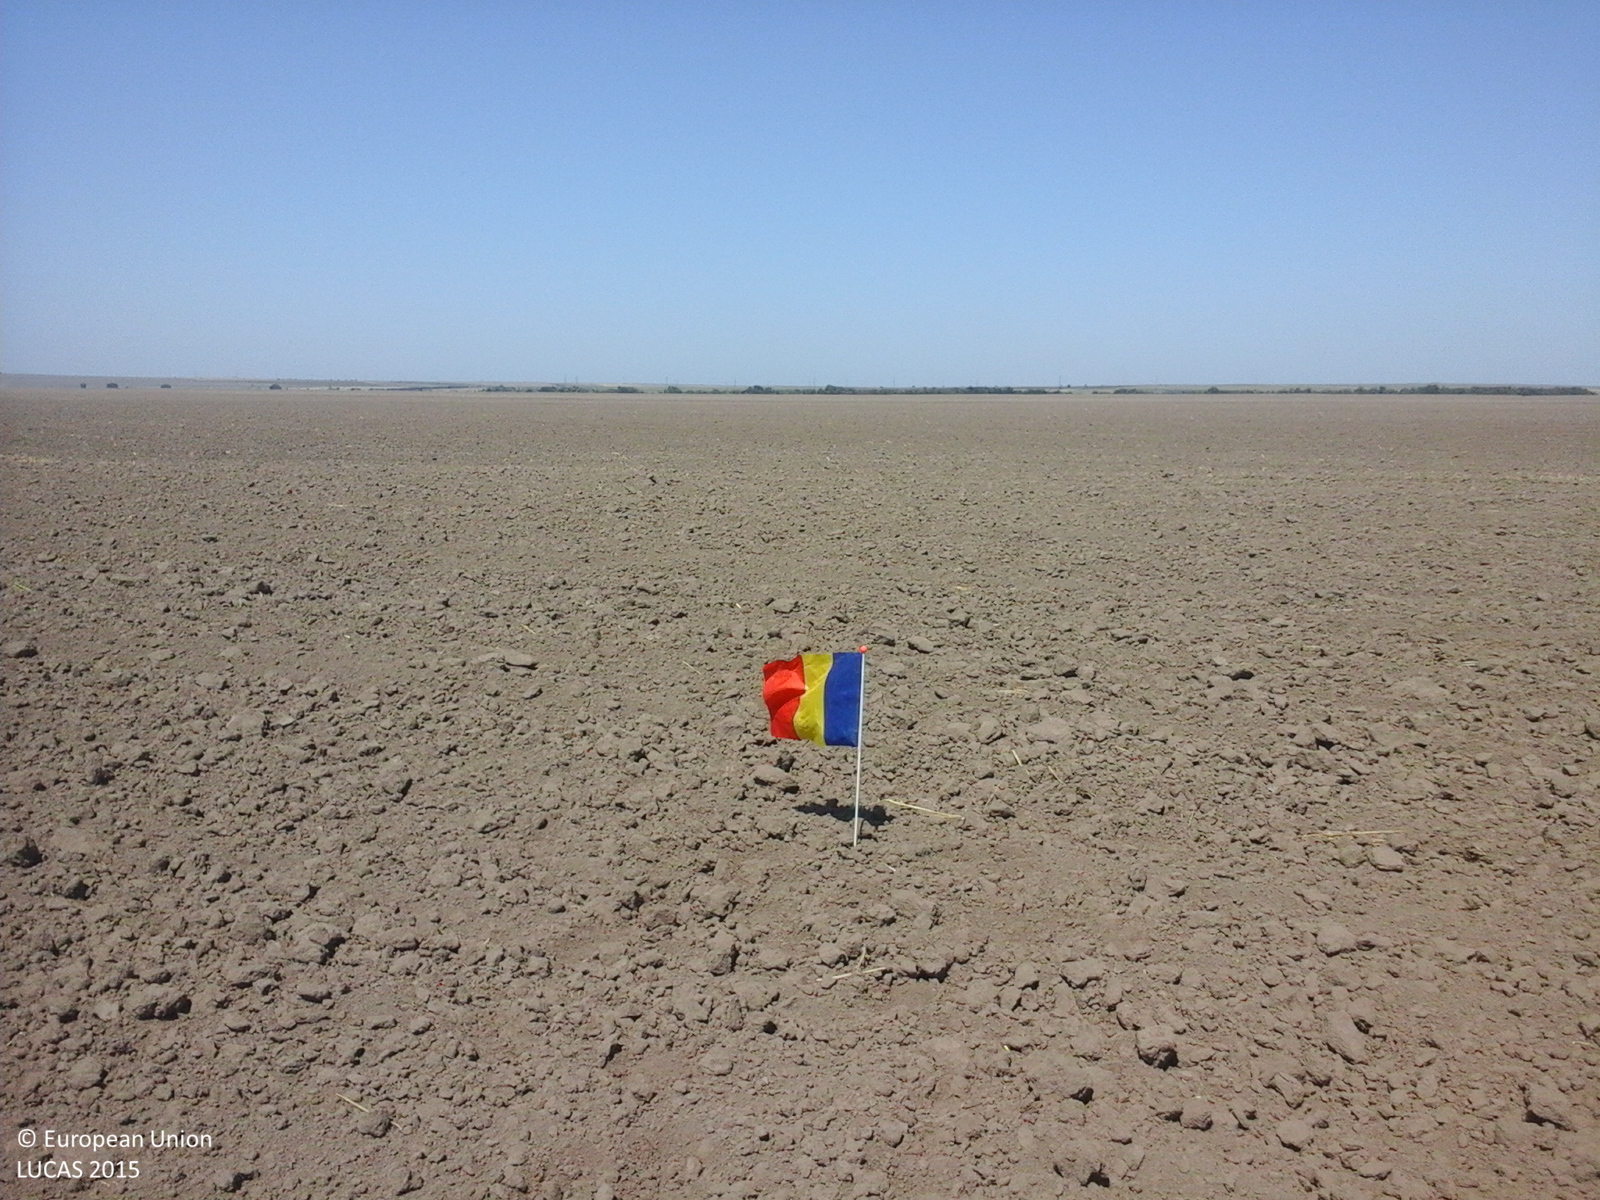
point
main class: Cropland
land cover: Barley
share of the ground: < 10 %
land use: Agriculture (excluding fallow land and kitchen gardens)
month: August
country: RO
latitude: 44.6159
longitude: 28.1468
